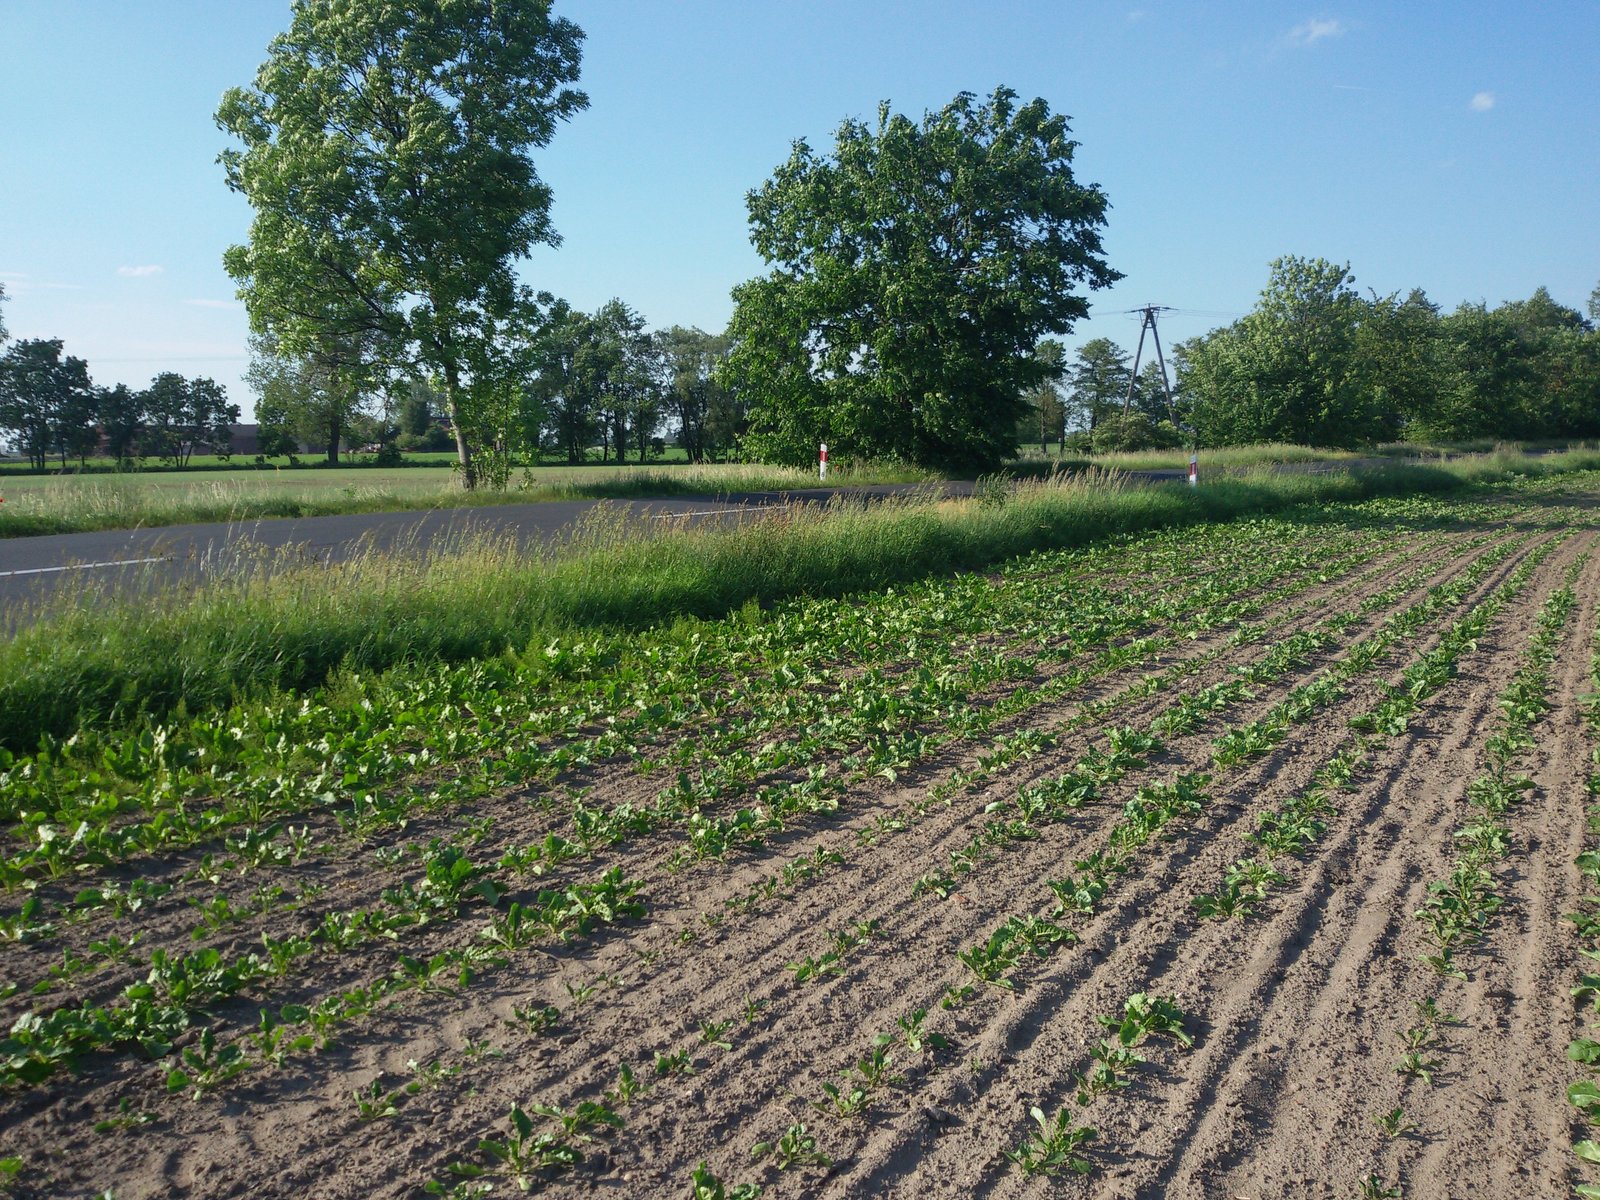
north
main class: Cropland
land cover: Sugar beet
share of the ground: 25 - 50 %
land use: Agriculture (excluding fallow land and kitchen gardens)
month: June
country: PL
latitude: 52.3239
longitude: 17.1560
